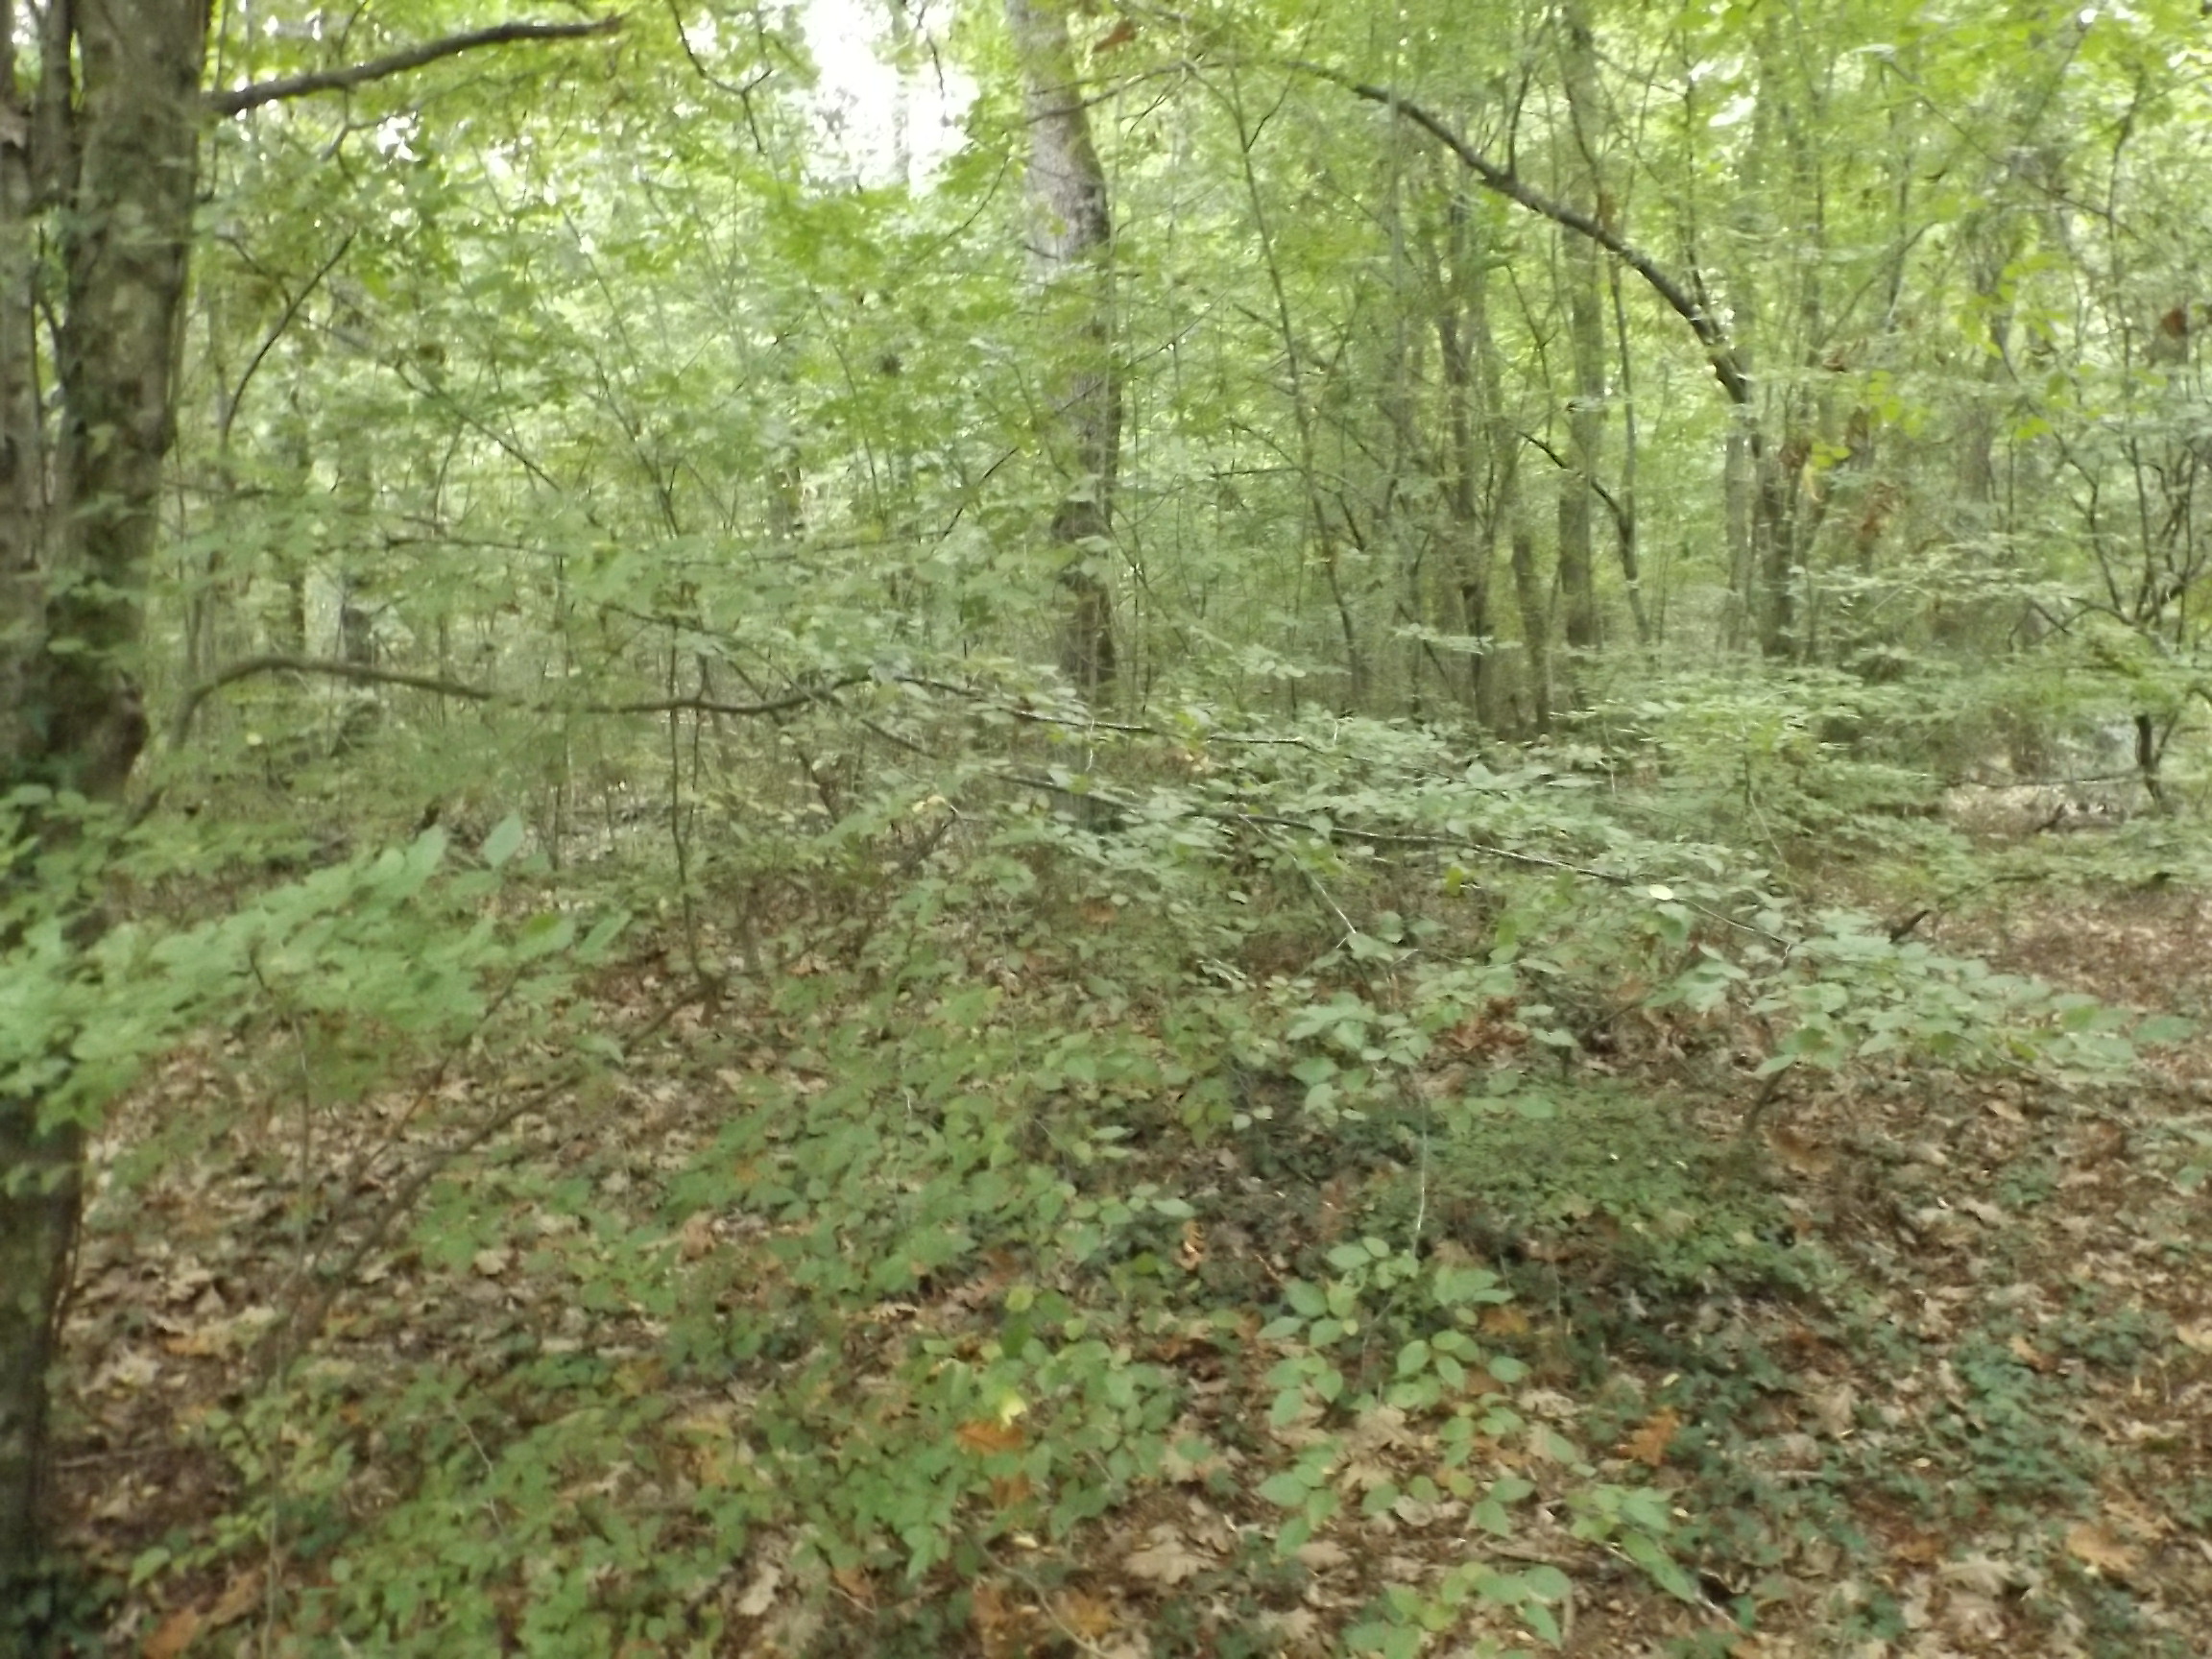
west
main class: Woodland
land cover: Broadleaved woodland
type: beech forest
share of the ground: > 75 %
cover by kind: broadleaved forest trees 100 %
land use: Forestry
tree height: > 5 m
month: October
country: BG
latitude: 42.9455
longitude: 27.8938
